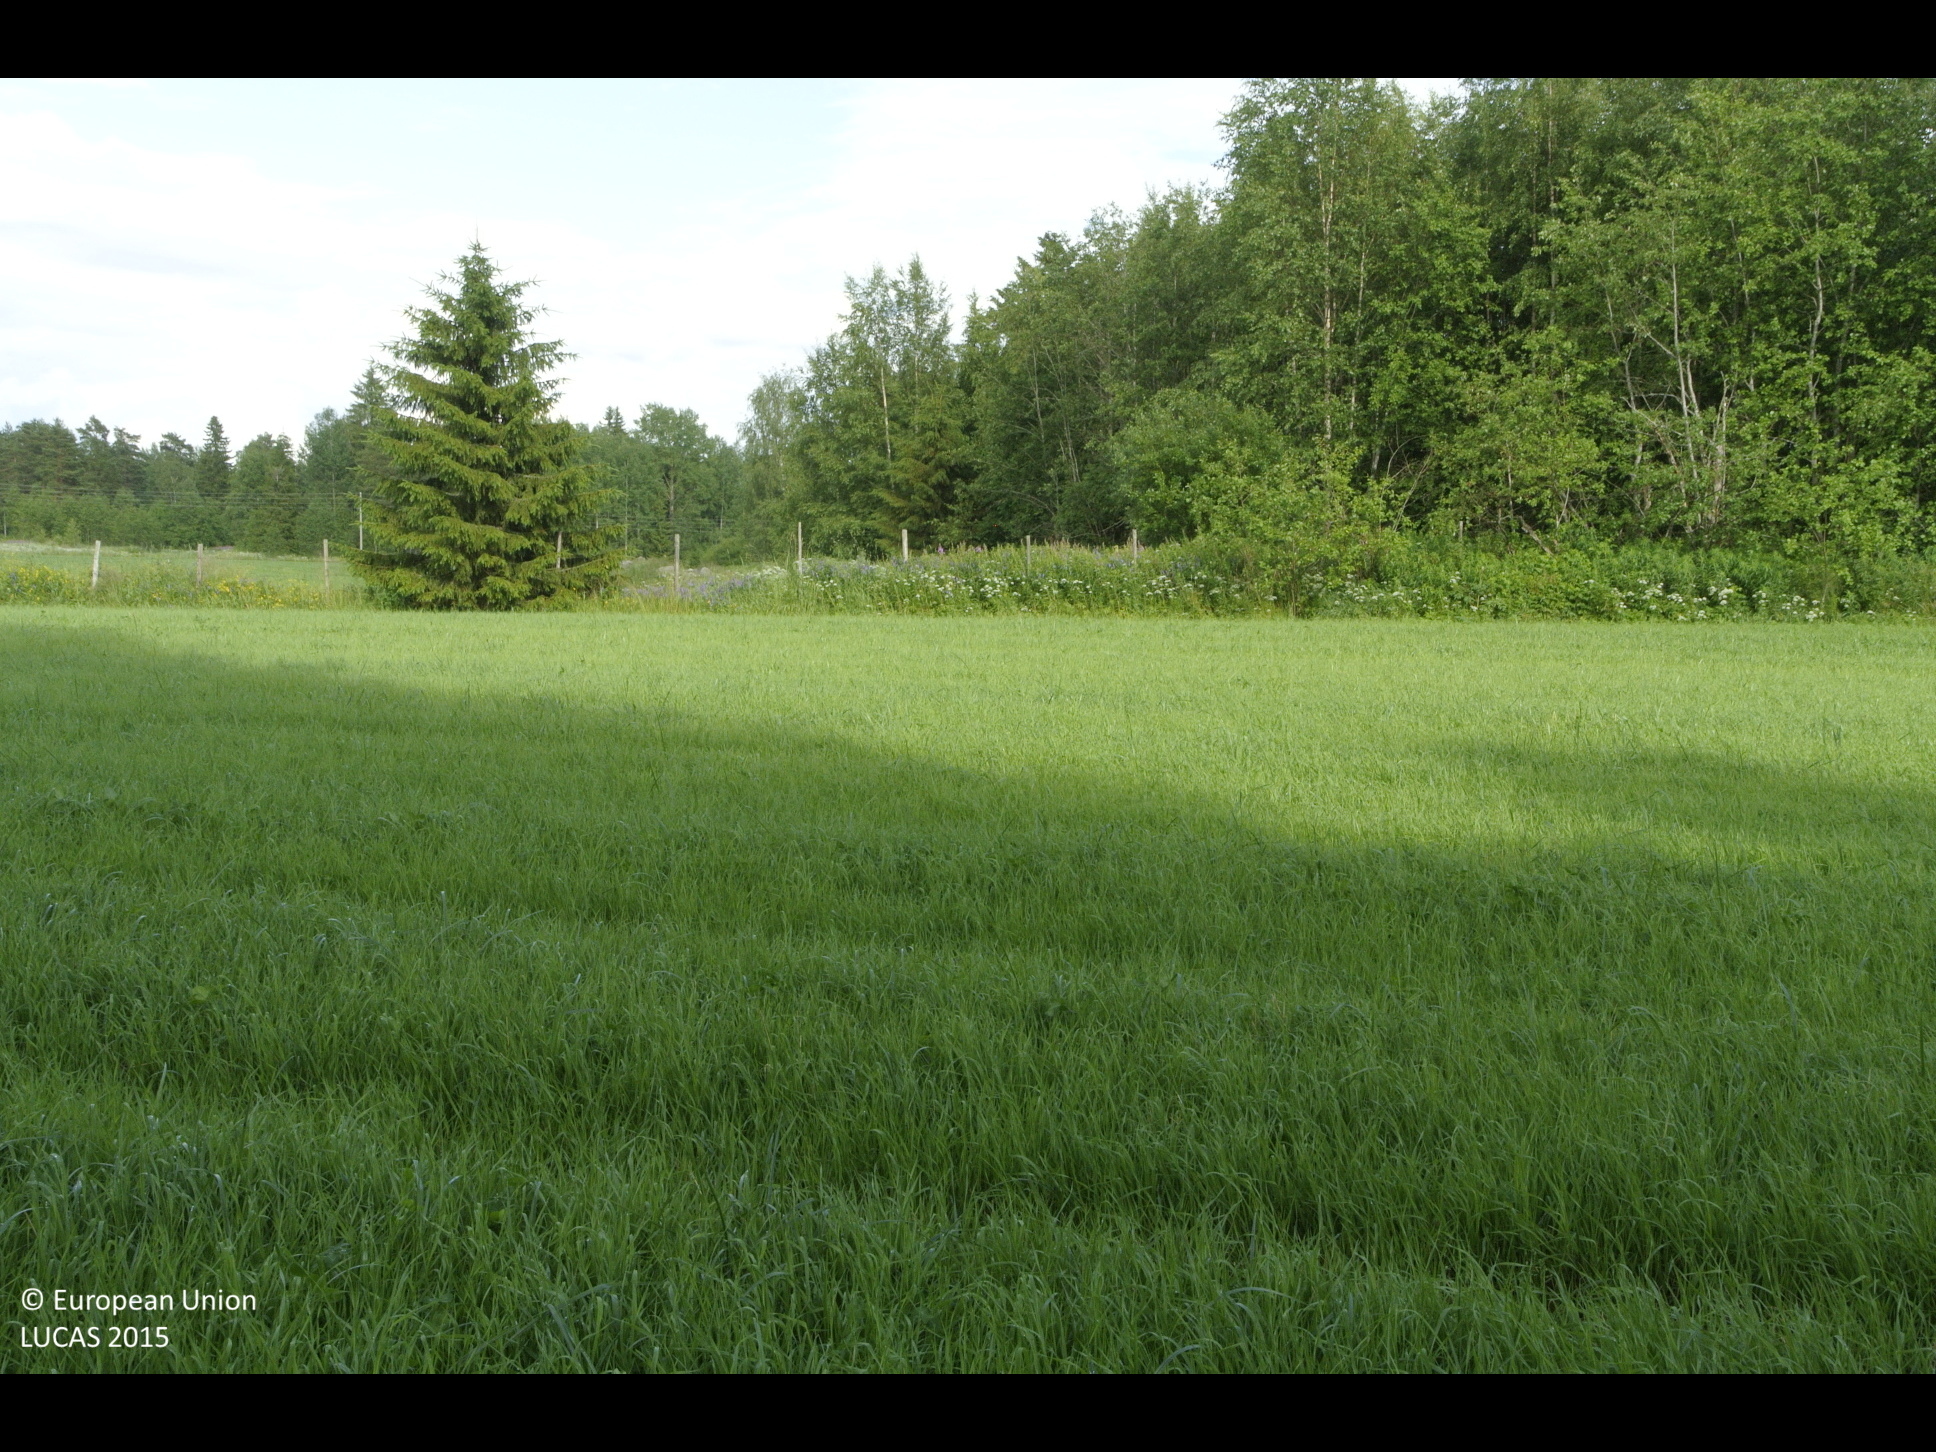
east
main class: Cropland
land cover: Other leguminous and mixtures for fodder
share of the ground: > 75 %
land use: Agriculture (excluding fallow land and kitchen gardens)
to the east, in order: Other leguminous and mixtures for fodder; Grass margins; Fences; Grass margins; Other leguminous and mixtures for fodder; Rocks and stones; Other leguminous and mixtures for fodder; Broadleaved woodland; Other leguminous and mixtures for fodder; Ditches and canals; Grass margins; Paved roads, cycling and walking lanes; Grass margins; Ditches and canals; Shruby margins; Electric lines; Barley; Grass margins; Broadleaved woodland
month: July
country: FI
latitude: 61.3910
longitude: 25.7224
